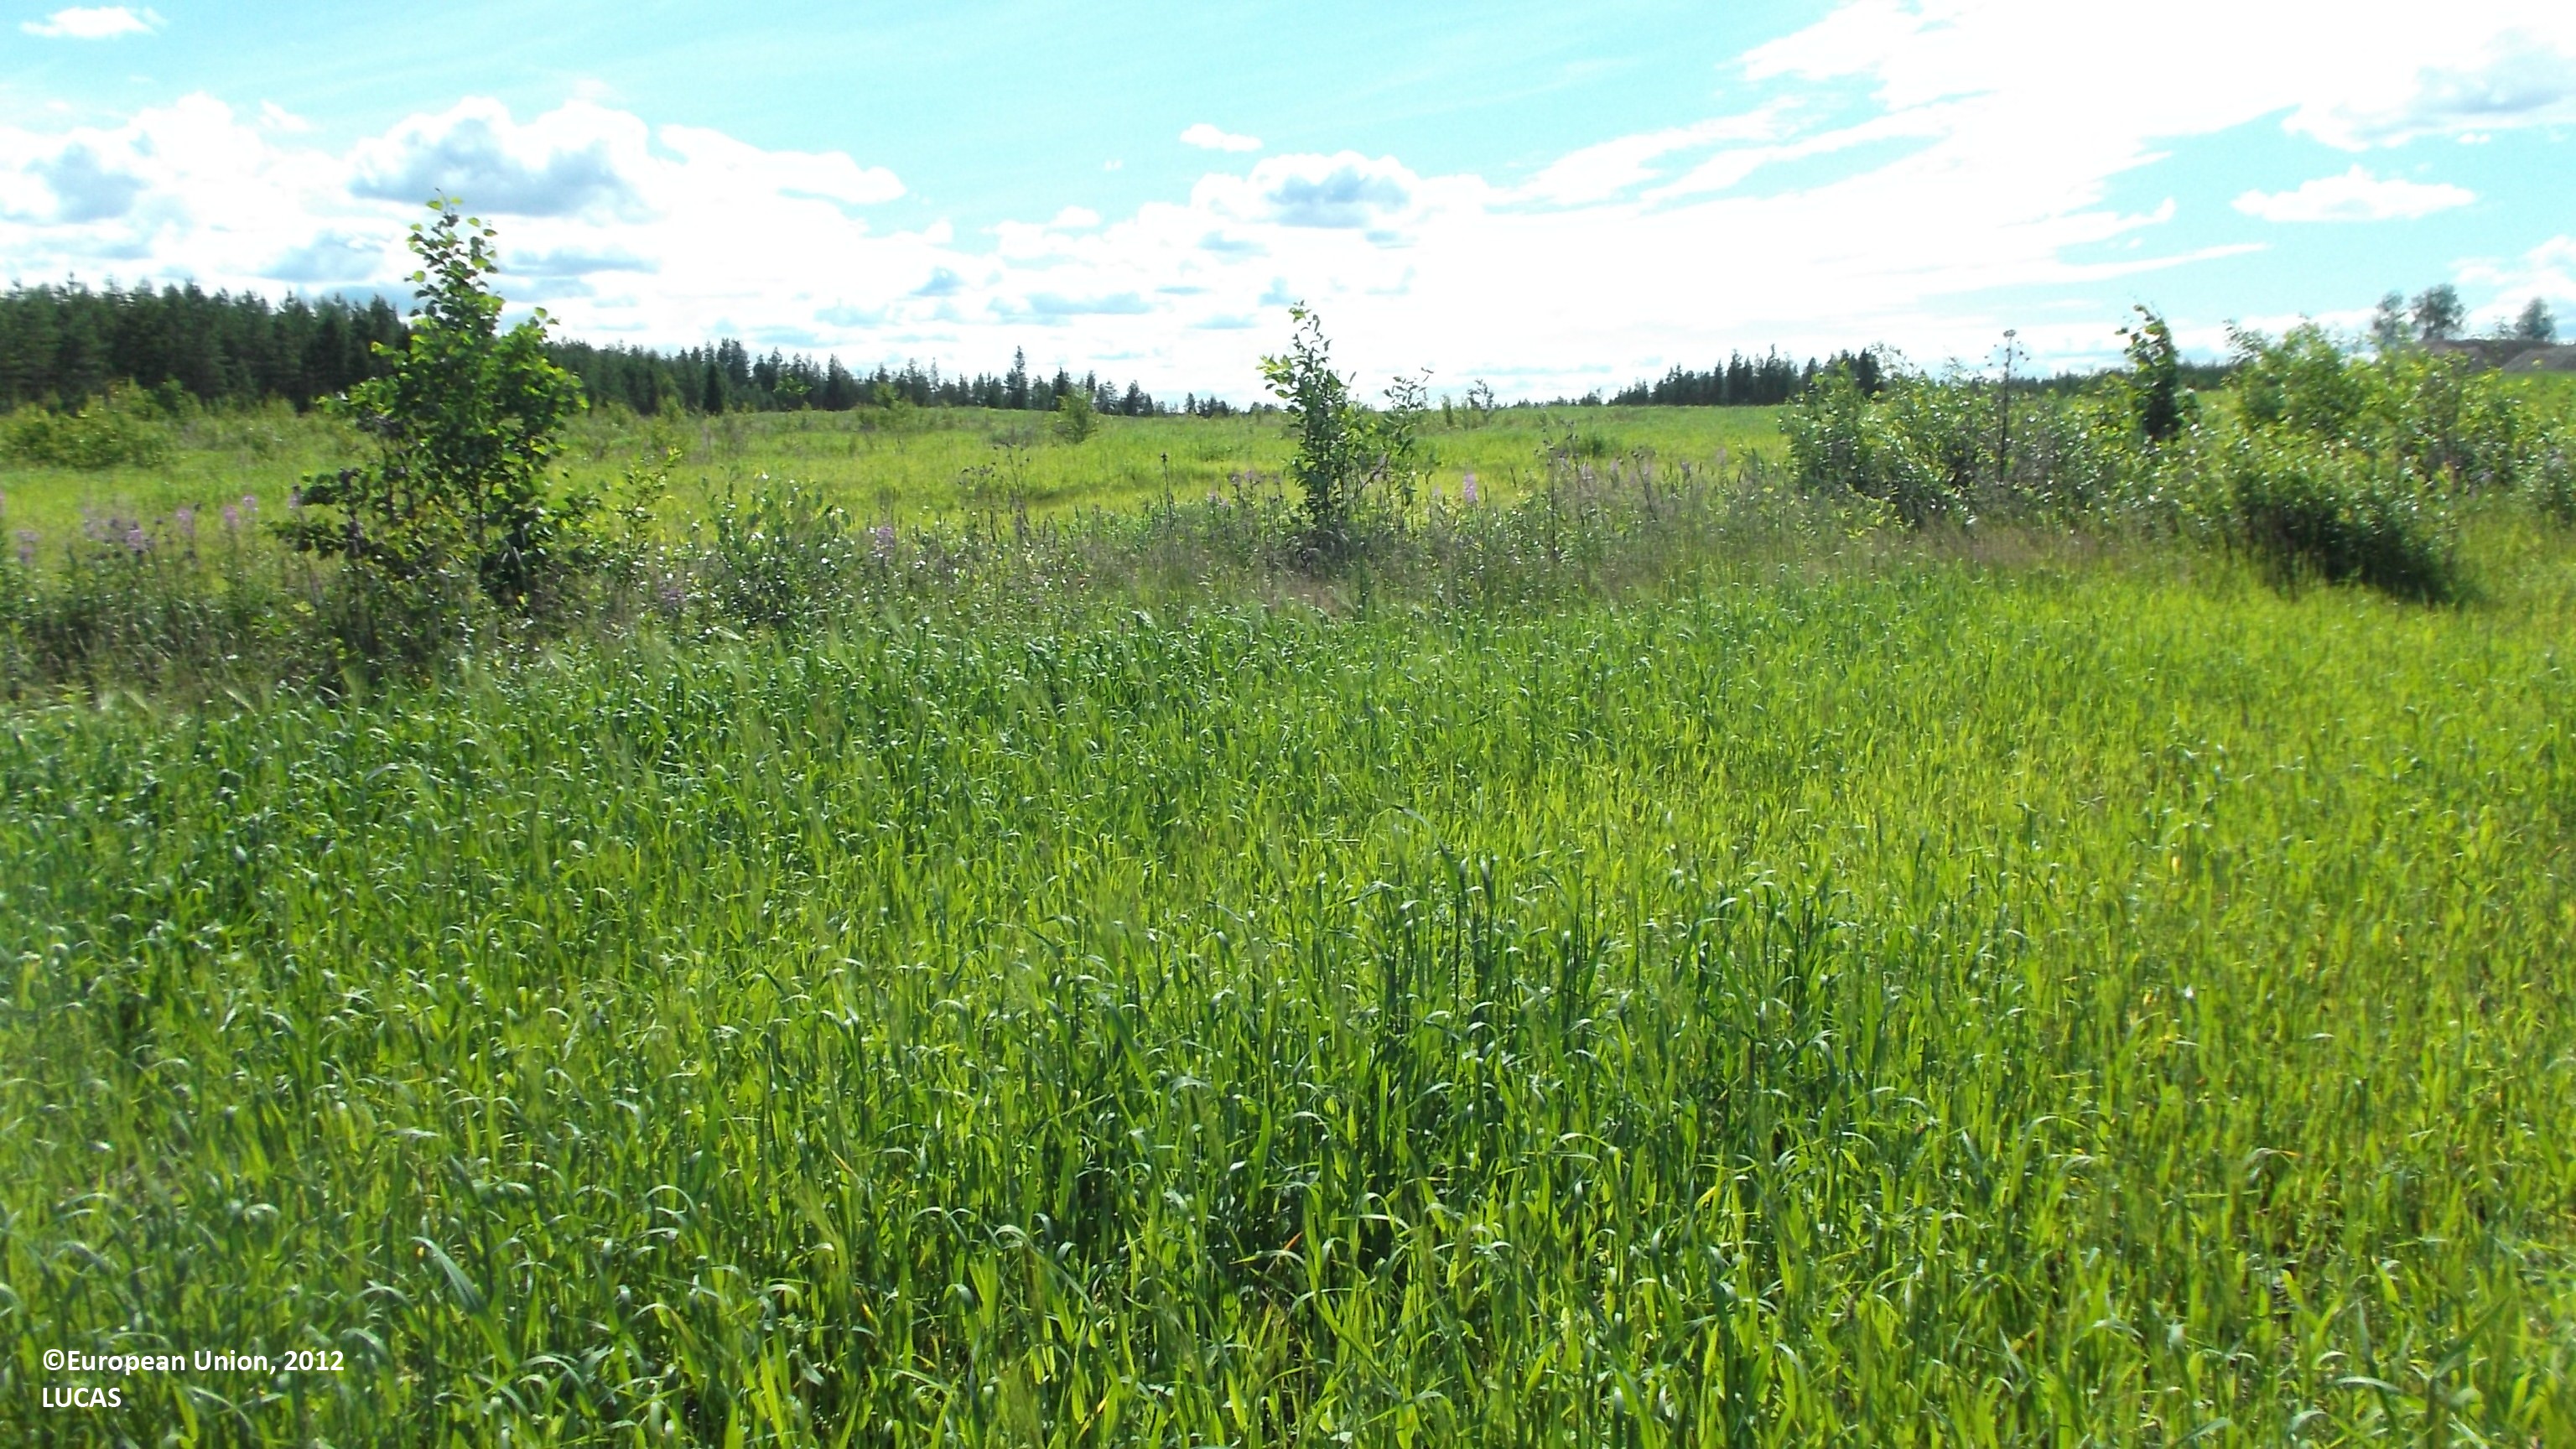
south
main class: Grassland
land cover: Grassland without tree/shrub cover
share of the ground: 25 - 50 %
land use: Fallow land
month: July
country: FI
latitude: 63.3259
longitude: 23.8667
